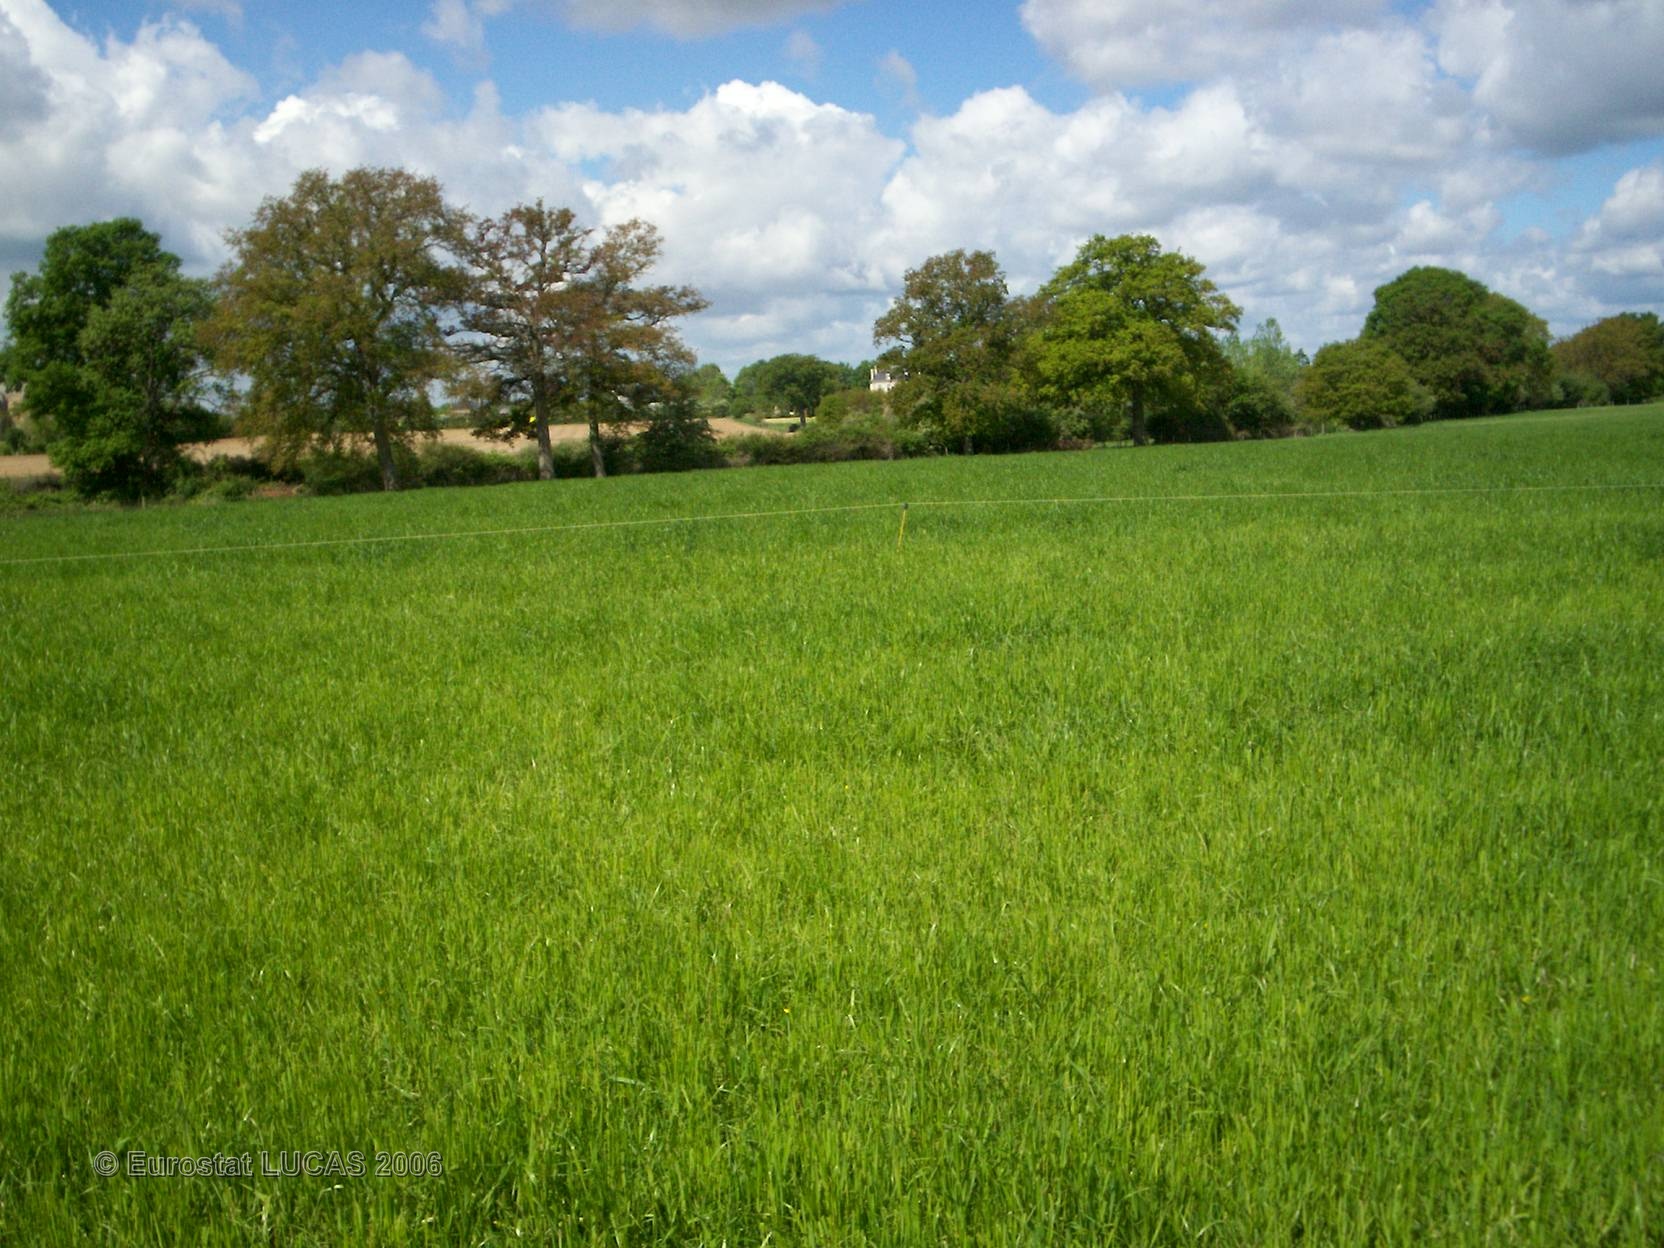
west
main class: Grassland
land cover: Grassland without tree/shrub cover
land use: Agriculture (excluding fallow land and kitchen gardens)
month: May
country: FR
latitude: 47.8971
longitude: -1.1016
